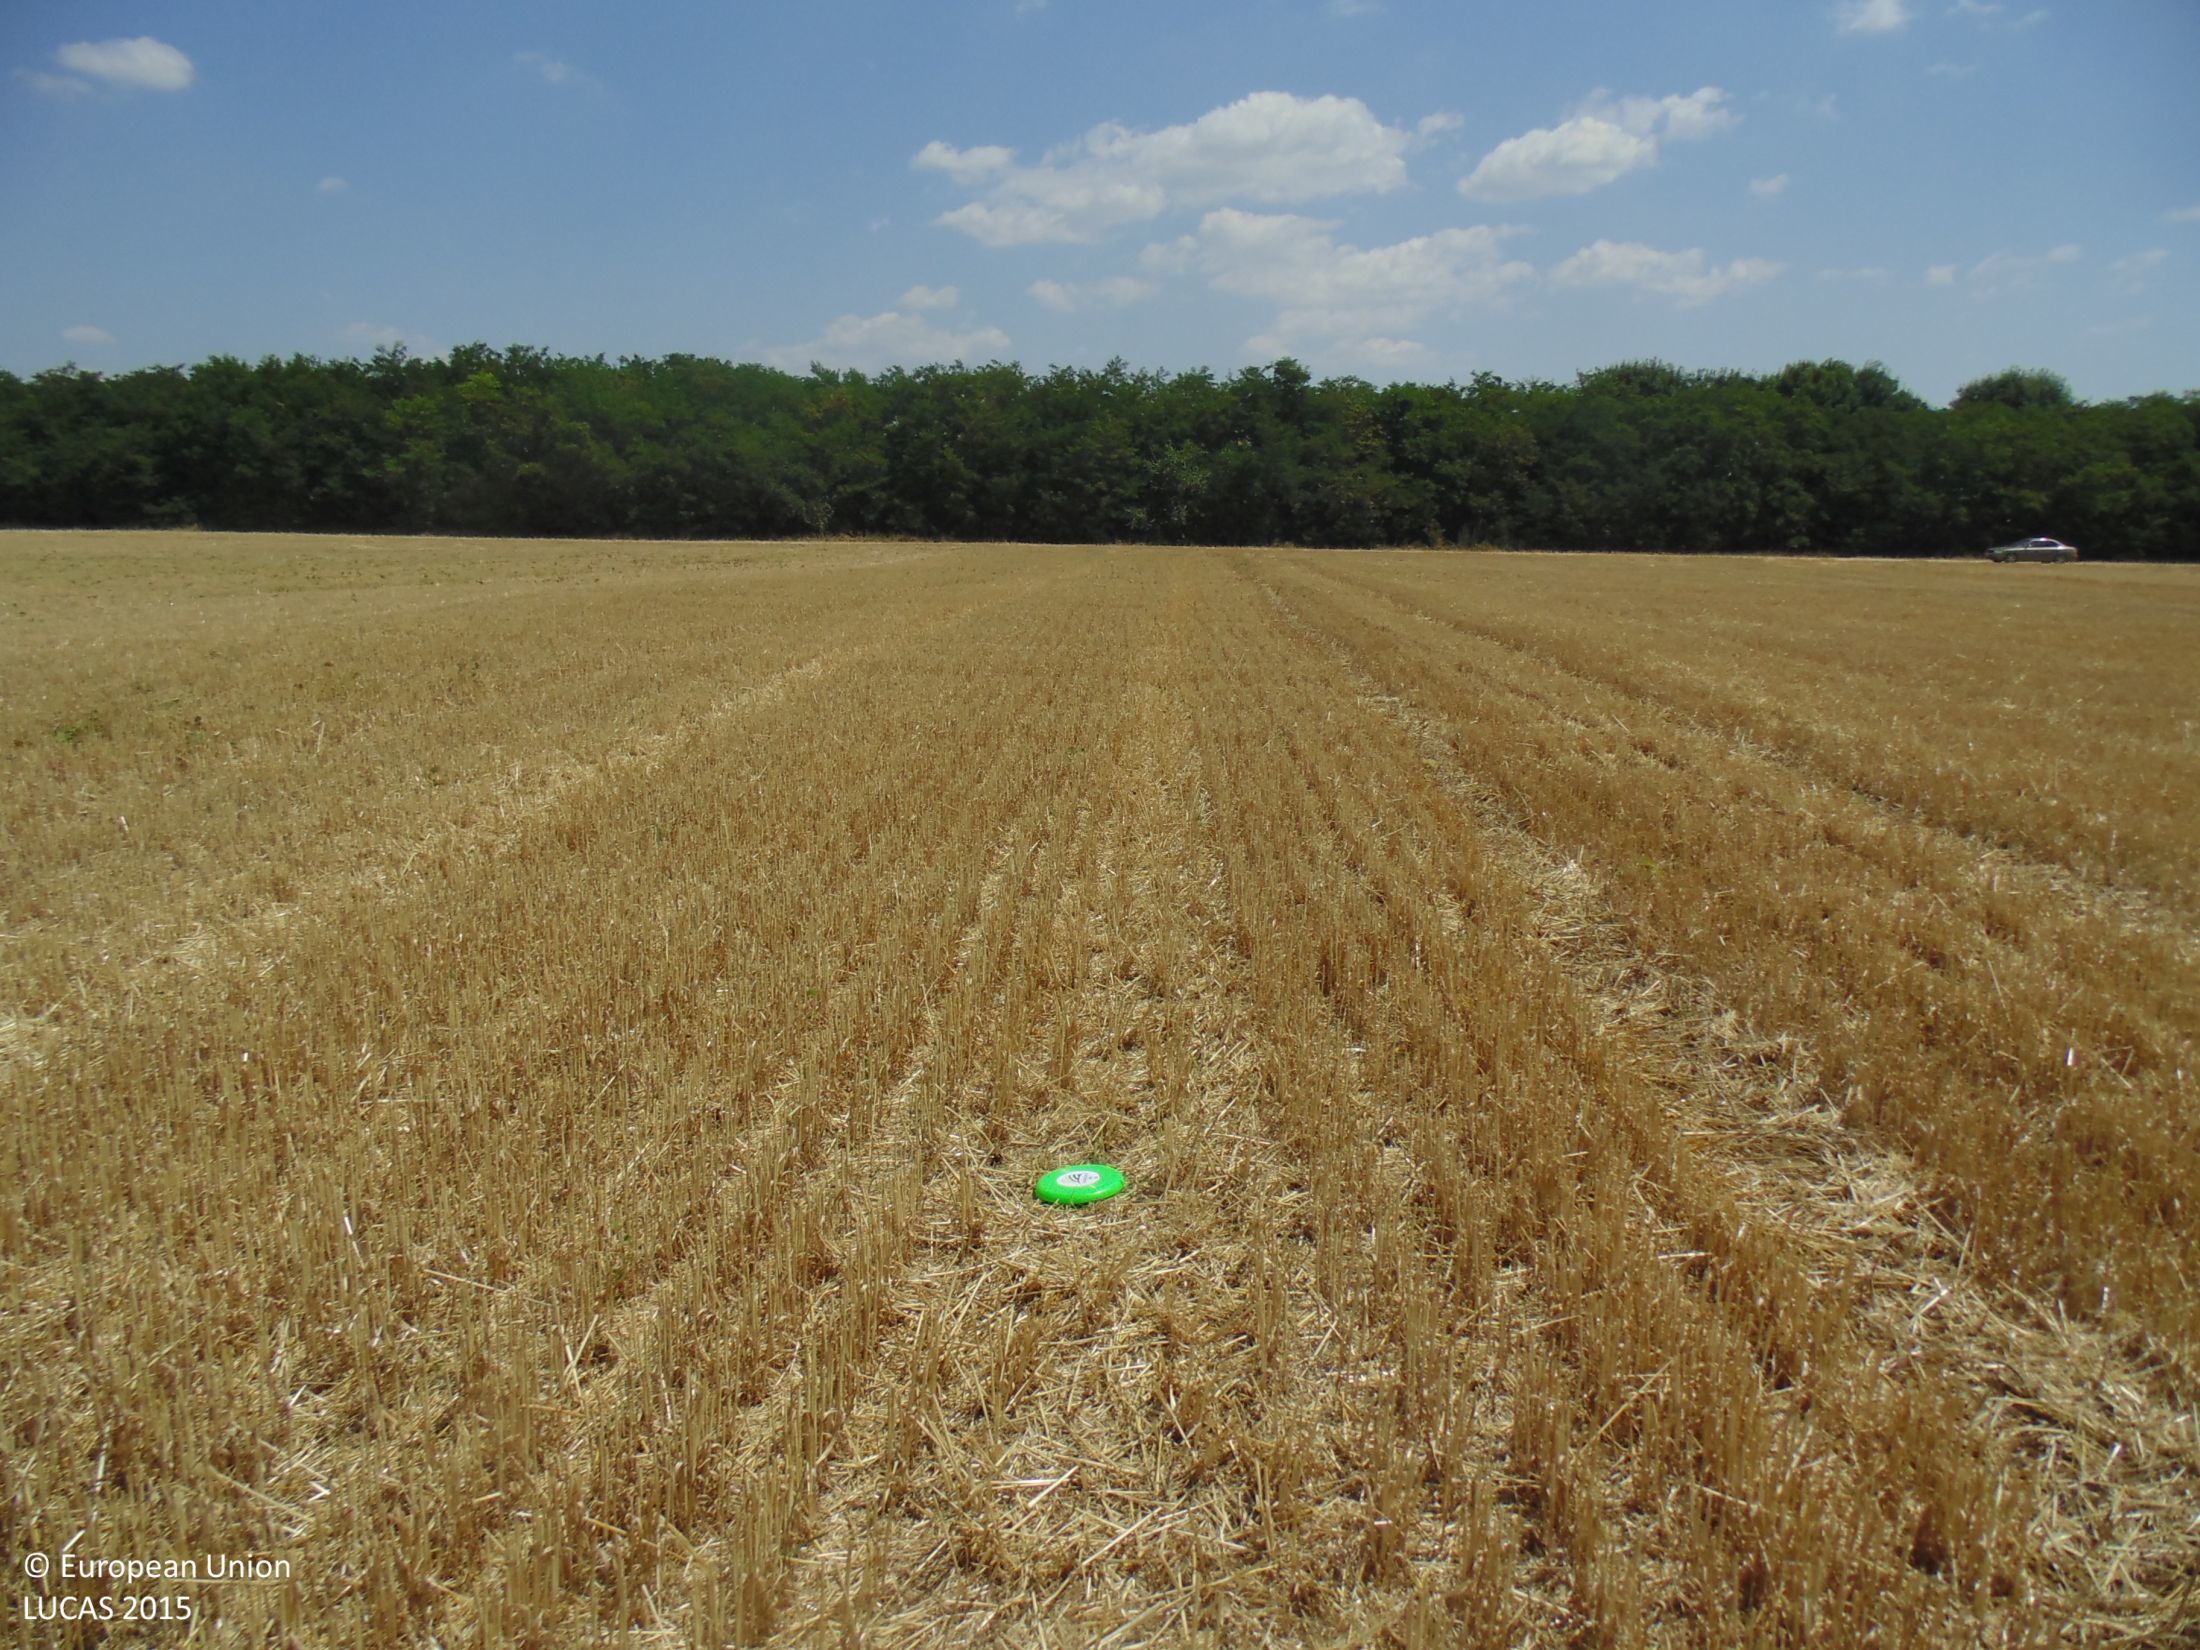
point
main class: Cropland
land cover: Common wheat
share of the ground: > 75 %
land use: Agriculture (excluding fallow land and kitchen gardens)
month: July
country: BG
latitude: 43.6861
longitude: 27.6673
